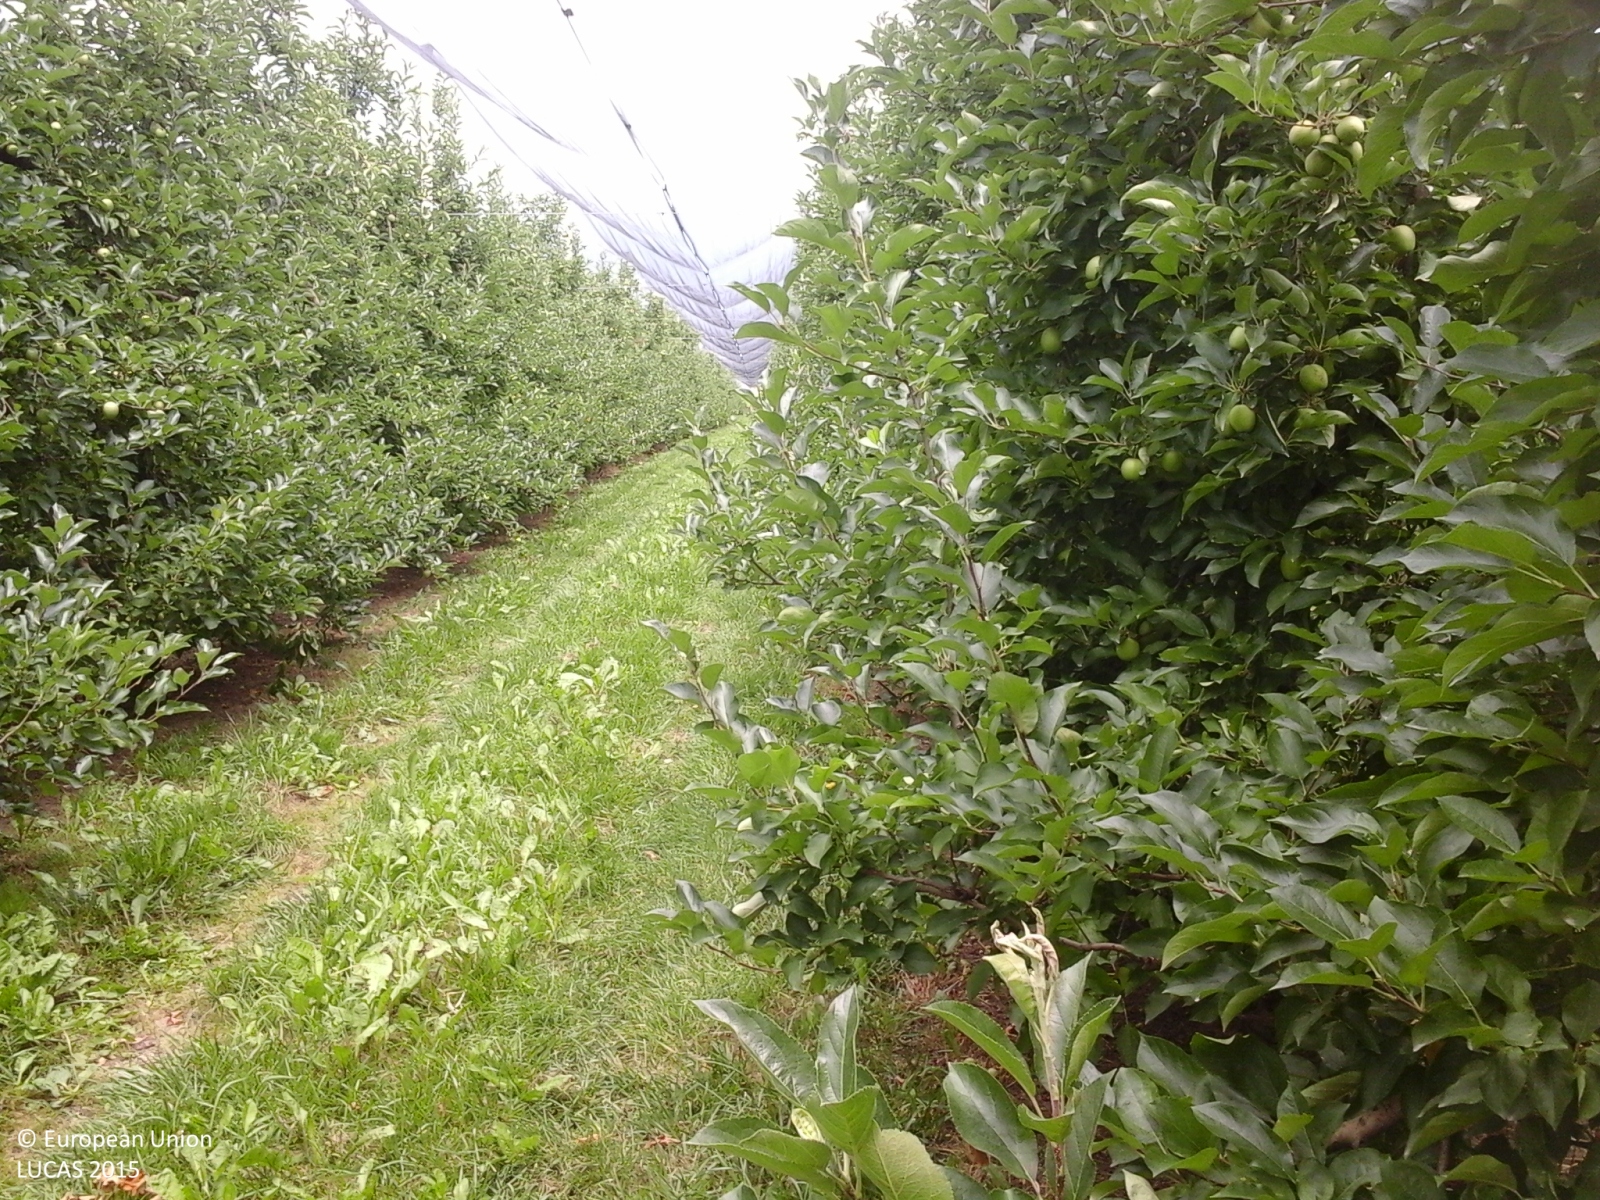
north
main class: Cropland
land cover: Apple fruit
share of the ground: 25 - 50 %
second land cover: Grassland without tree/shrub cover
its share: > 75 %
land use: Agriculture (excluding fallow land and kitchen gardens)
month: June
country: IT
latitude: 45.3896
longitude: 11.1858
